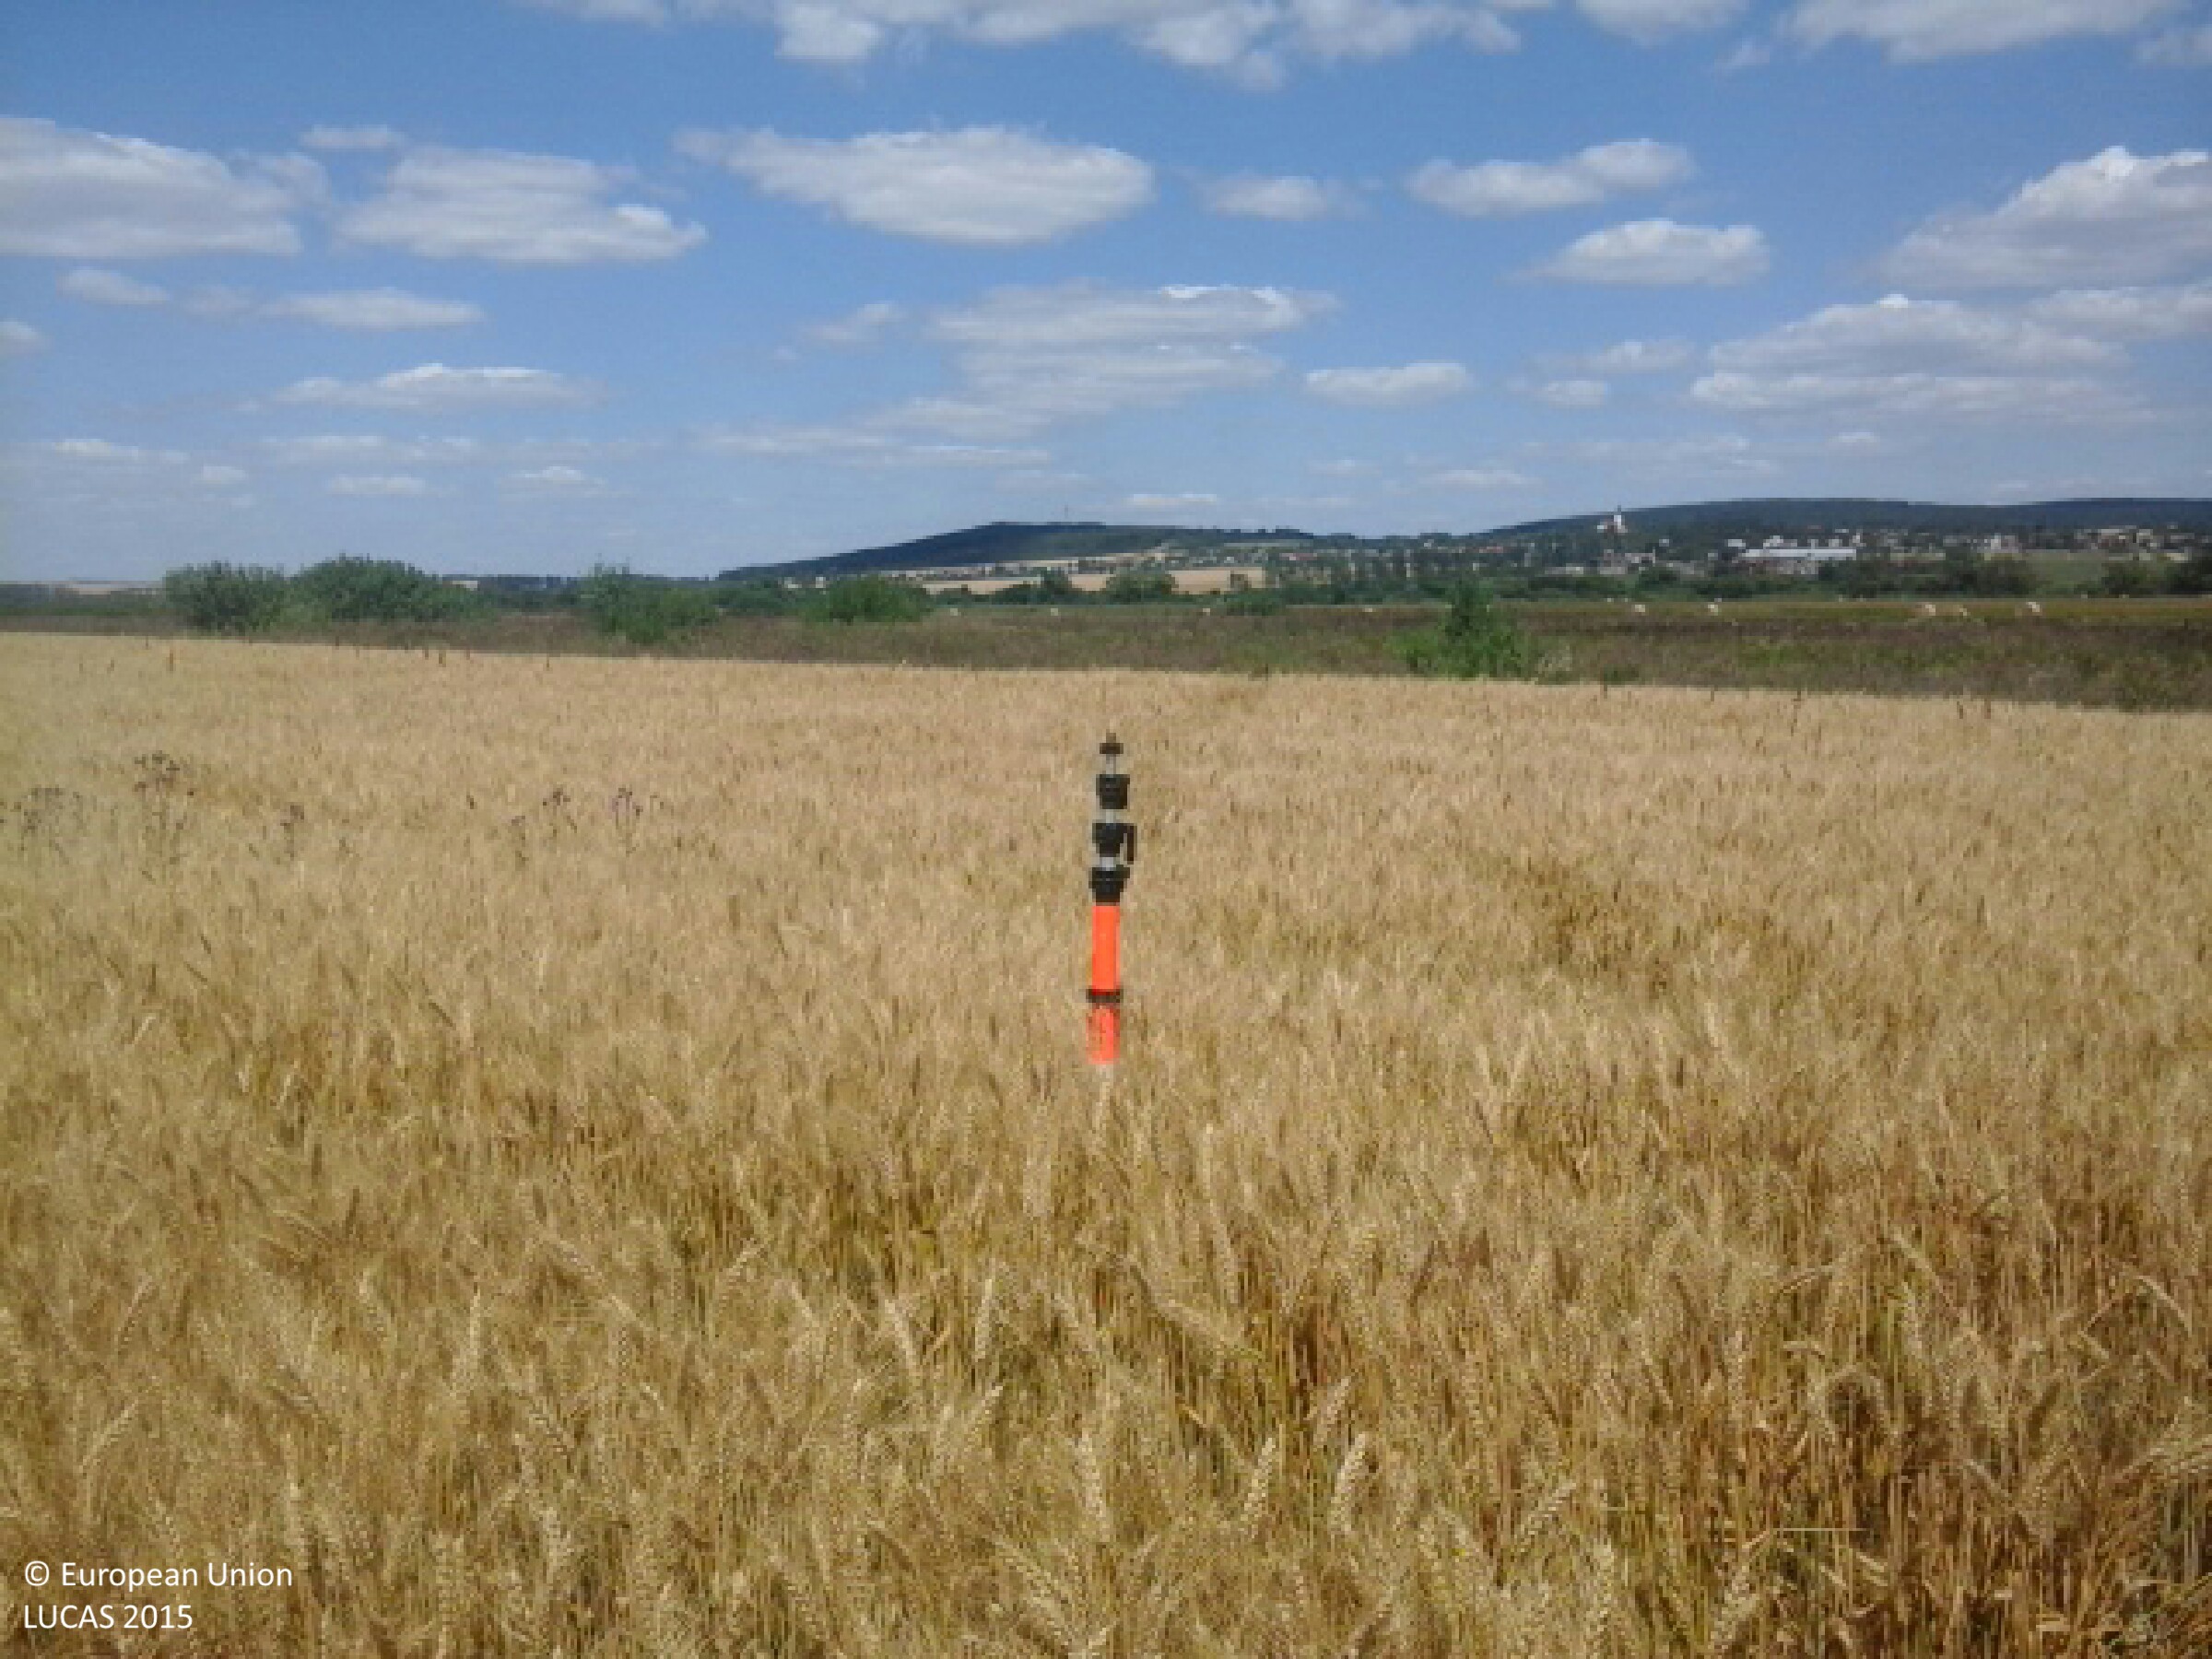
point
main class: Cropland
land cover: Triticale
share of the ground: > 75 %
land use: Agriculture (excluding fallow land and kitchen gardens)
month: July
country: HU
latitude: 48.4797
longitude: 21.6152
